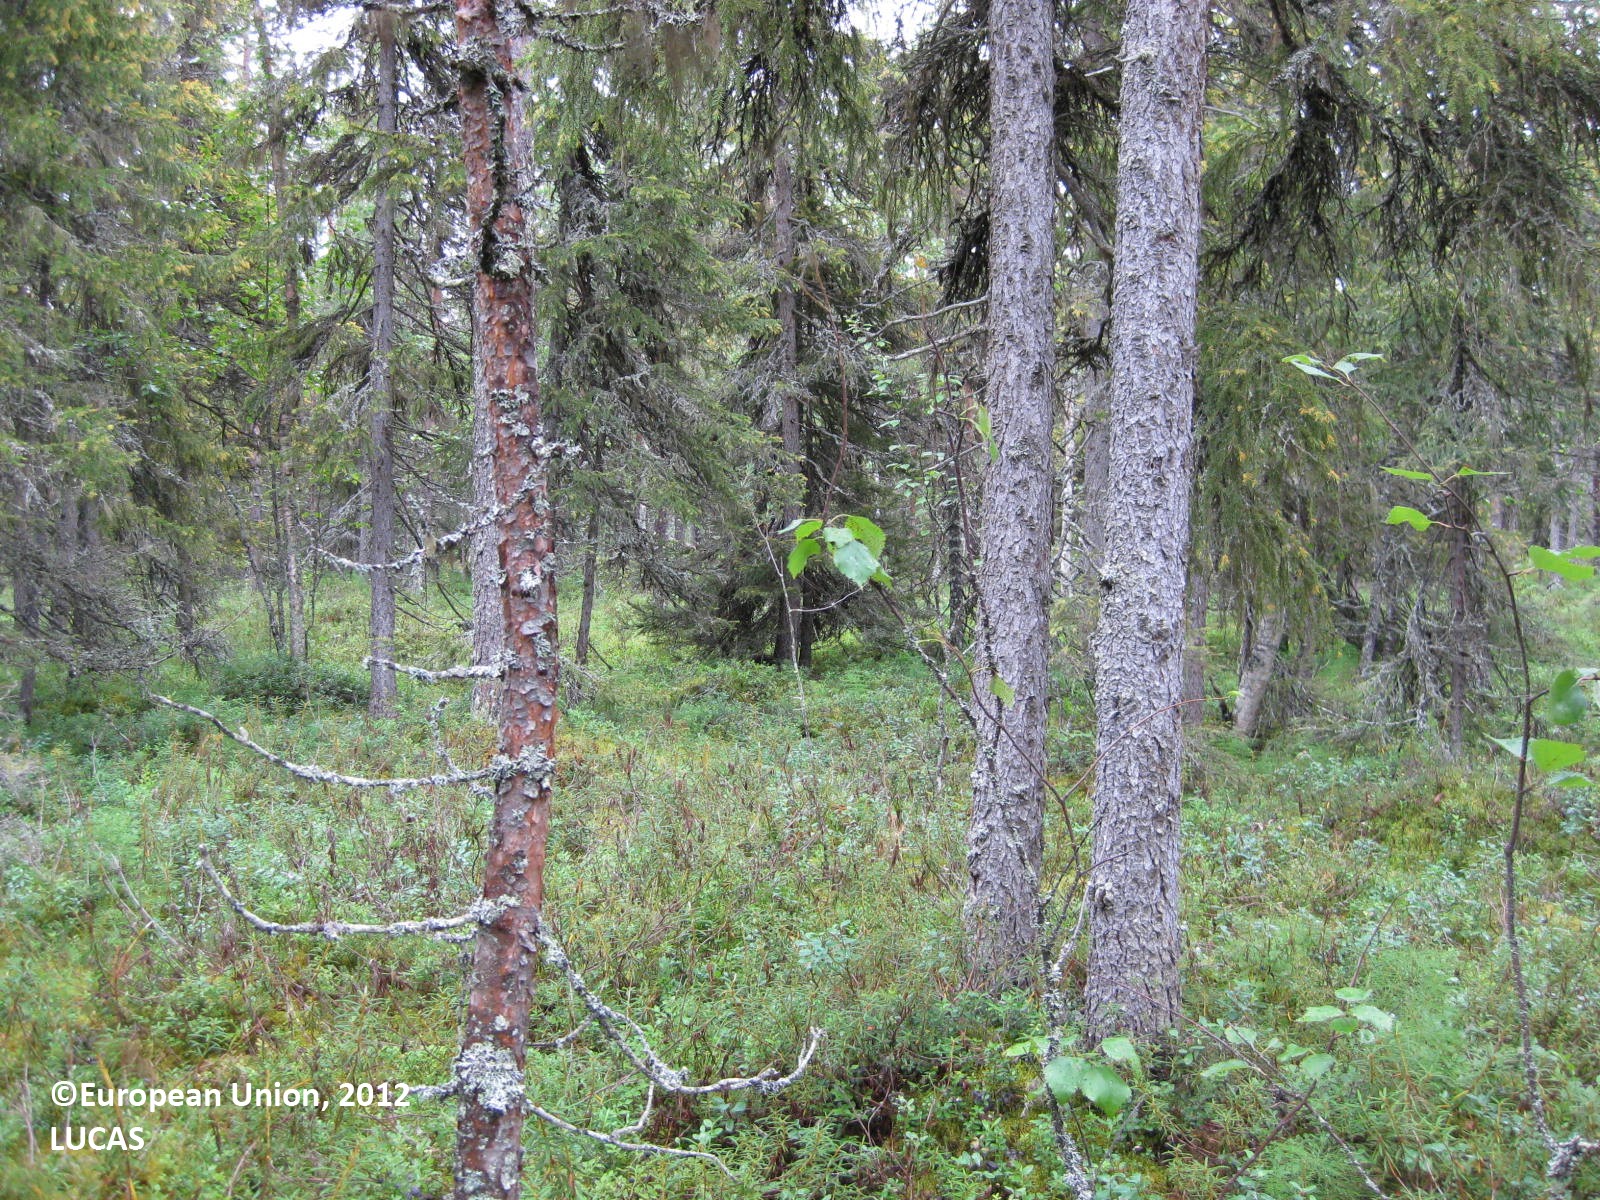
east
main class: Woodland
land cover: Spruce dominated coniferous woodland
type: boreal forest
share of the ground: > 75 %
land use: Forestry
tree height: > 5 m
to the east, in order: Spruce dominated coniferous woodland; Ditches and canals; Pine dominated mixed woodland; Other coniferous woodland; Ditches and canals; Pine dominated coniferous woodland; Ditches and canals; Pine dominated coniferous woodland; Ditches and canals; Pine dominated coniferous woodland; Ditches and canals; Pine dominated coniferous woodland
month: August
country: FI
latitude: 65.8845
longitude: 28.2427
